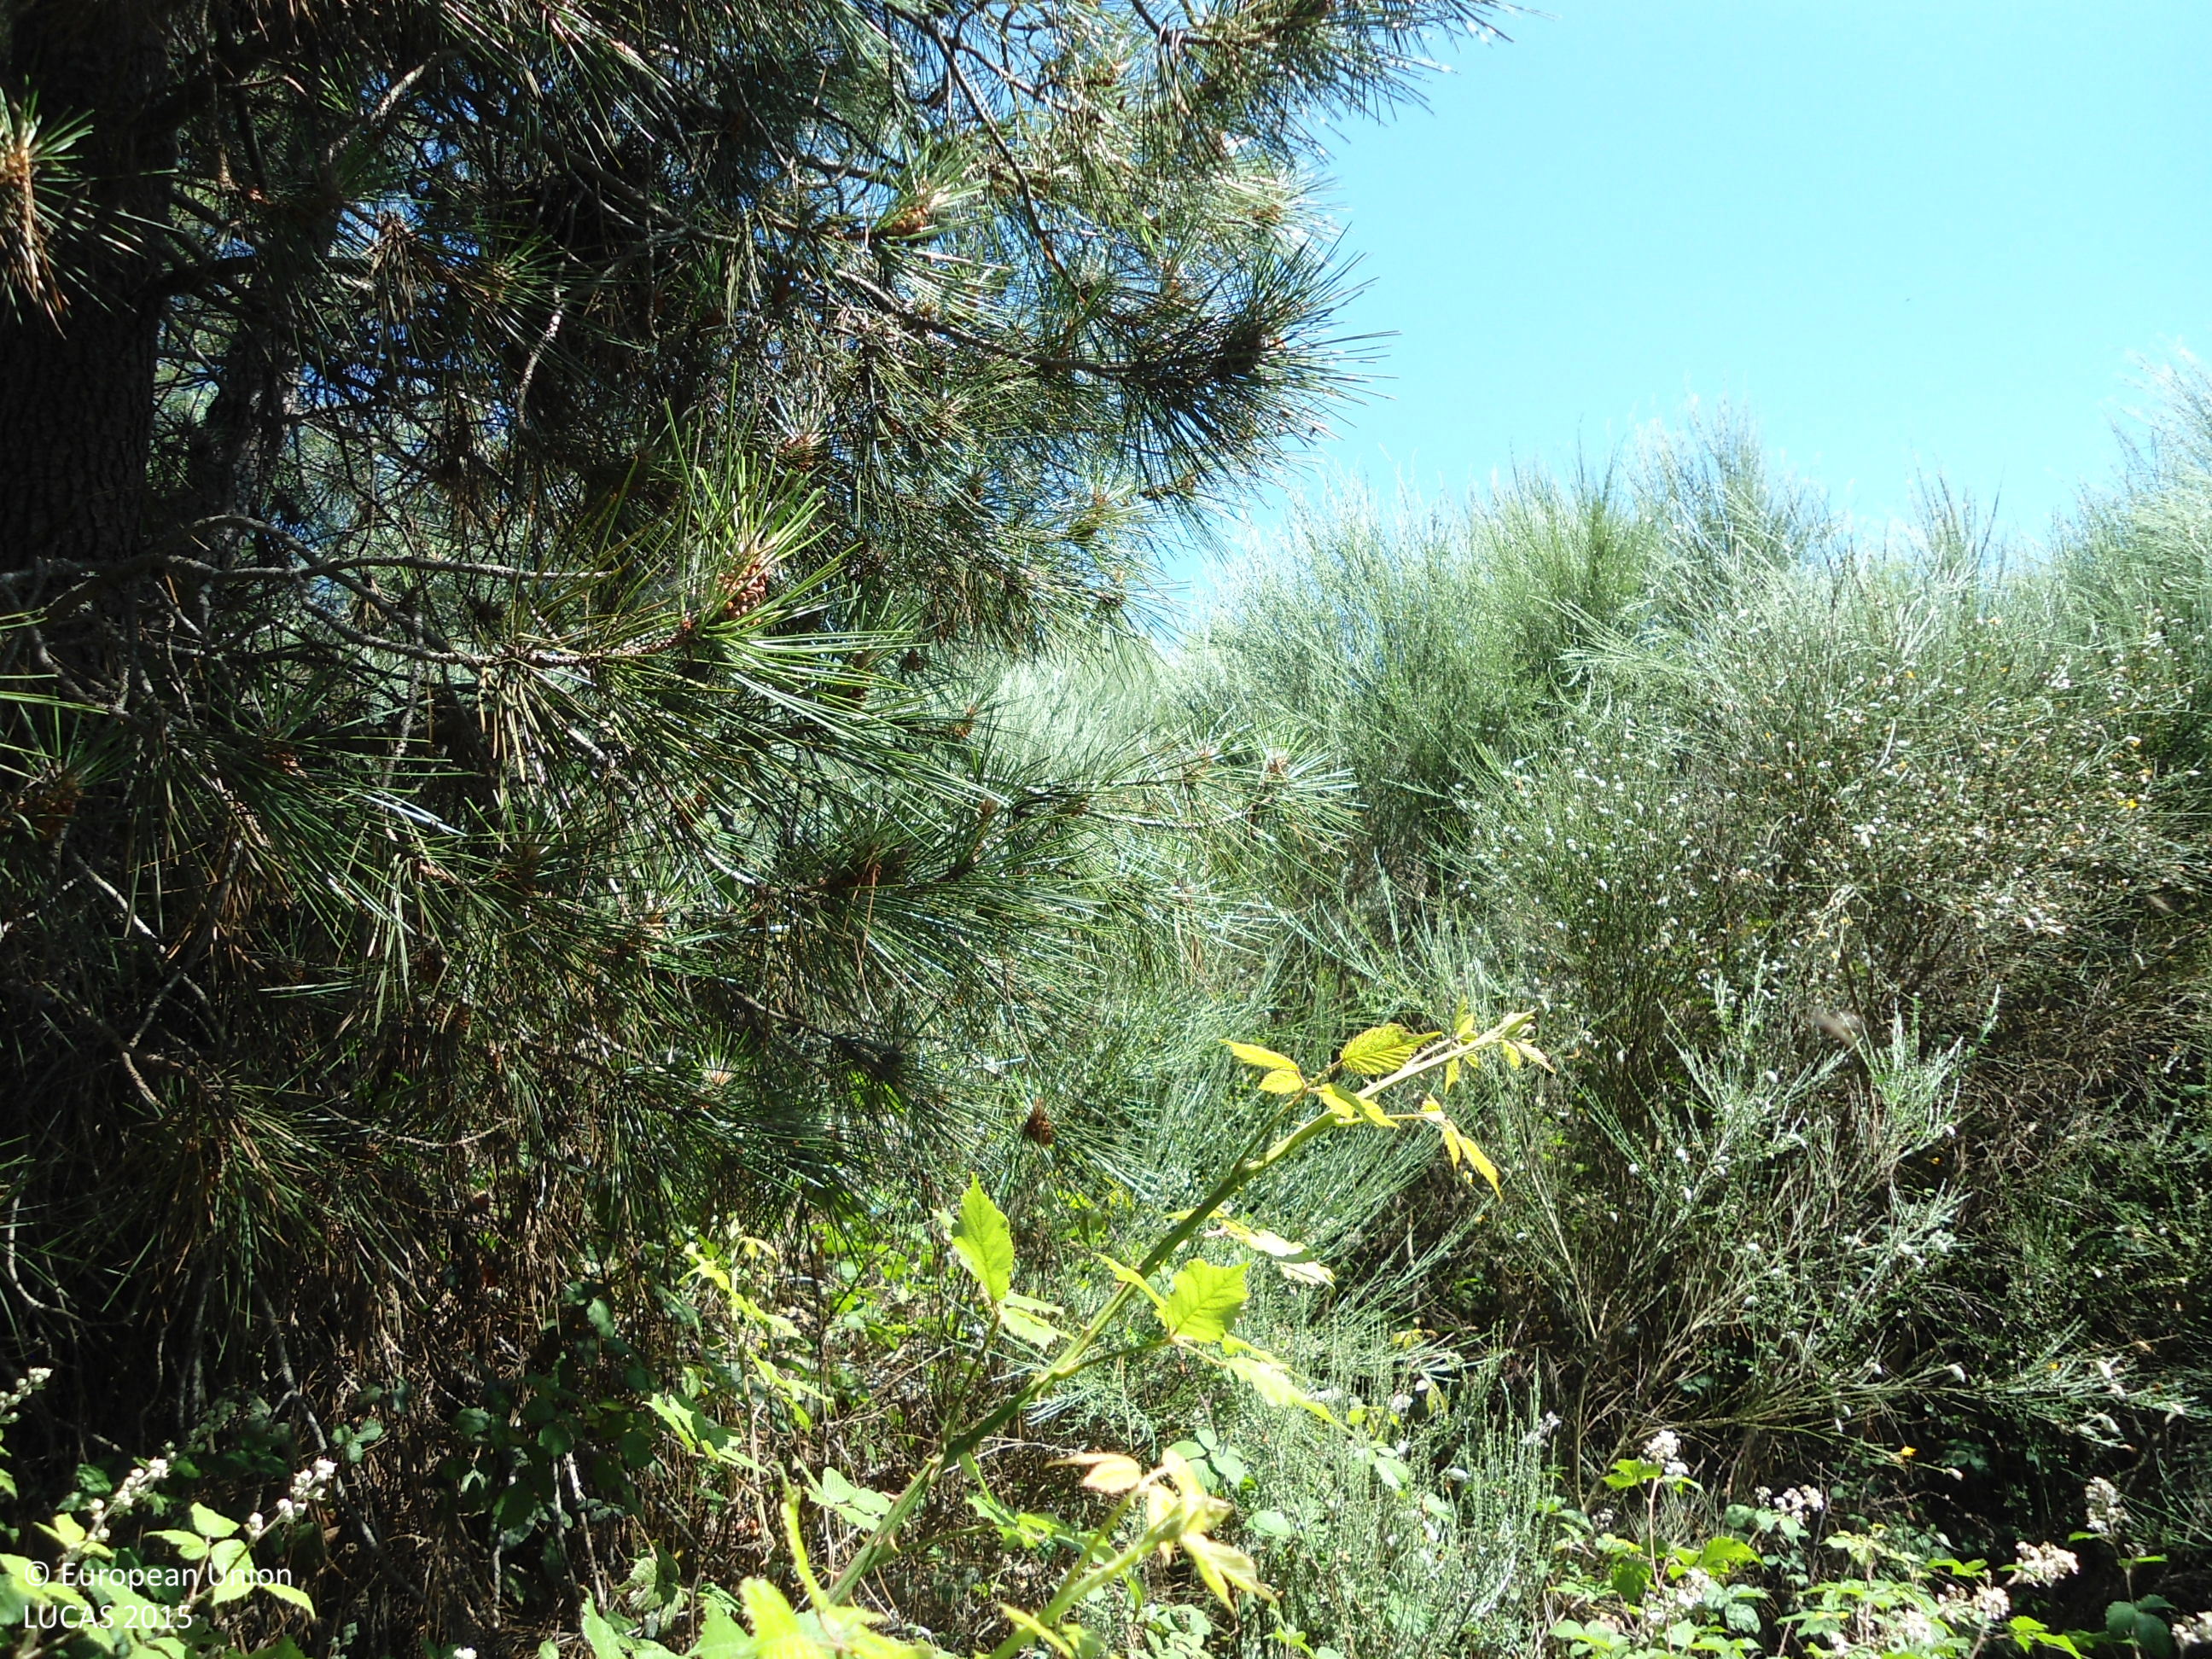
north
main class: Woodland
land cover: Pine dominated coniferous woodland
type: coniferous forest of the mediterranean region
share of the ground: 25 - 50 %
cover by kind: shrubs 70 %, coniferous forest trees 30 %
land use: Forestry
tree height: > 5 m
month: June
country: ES
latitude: 41.9146
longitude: -7.2598
